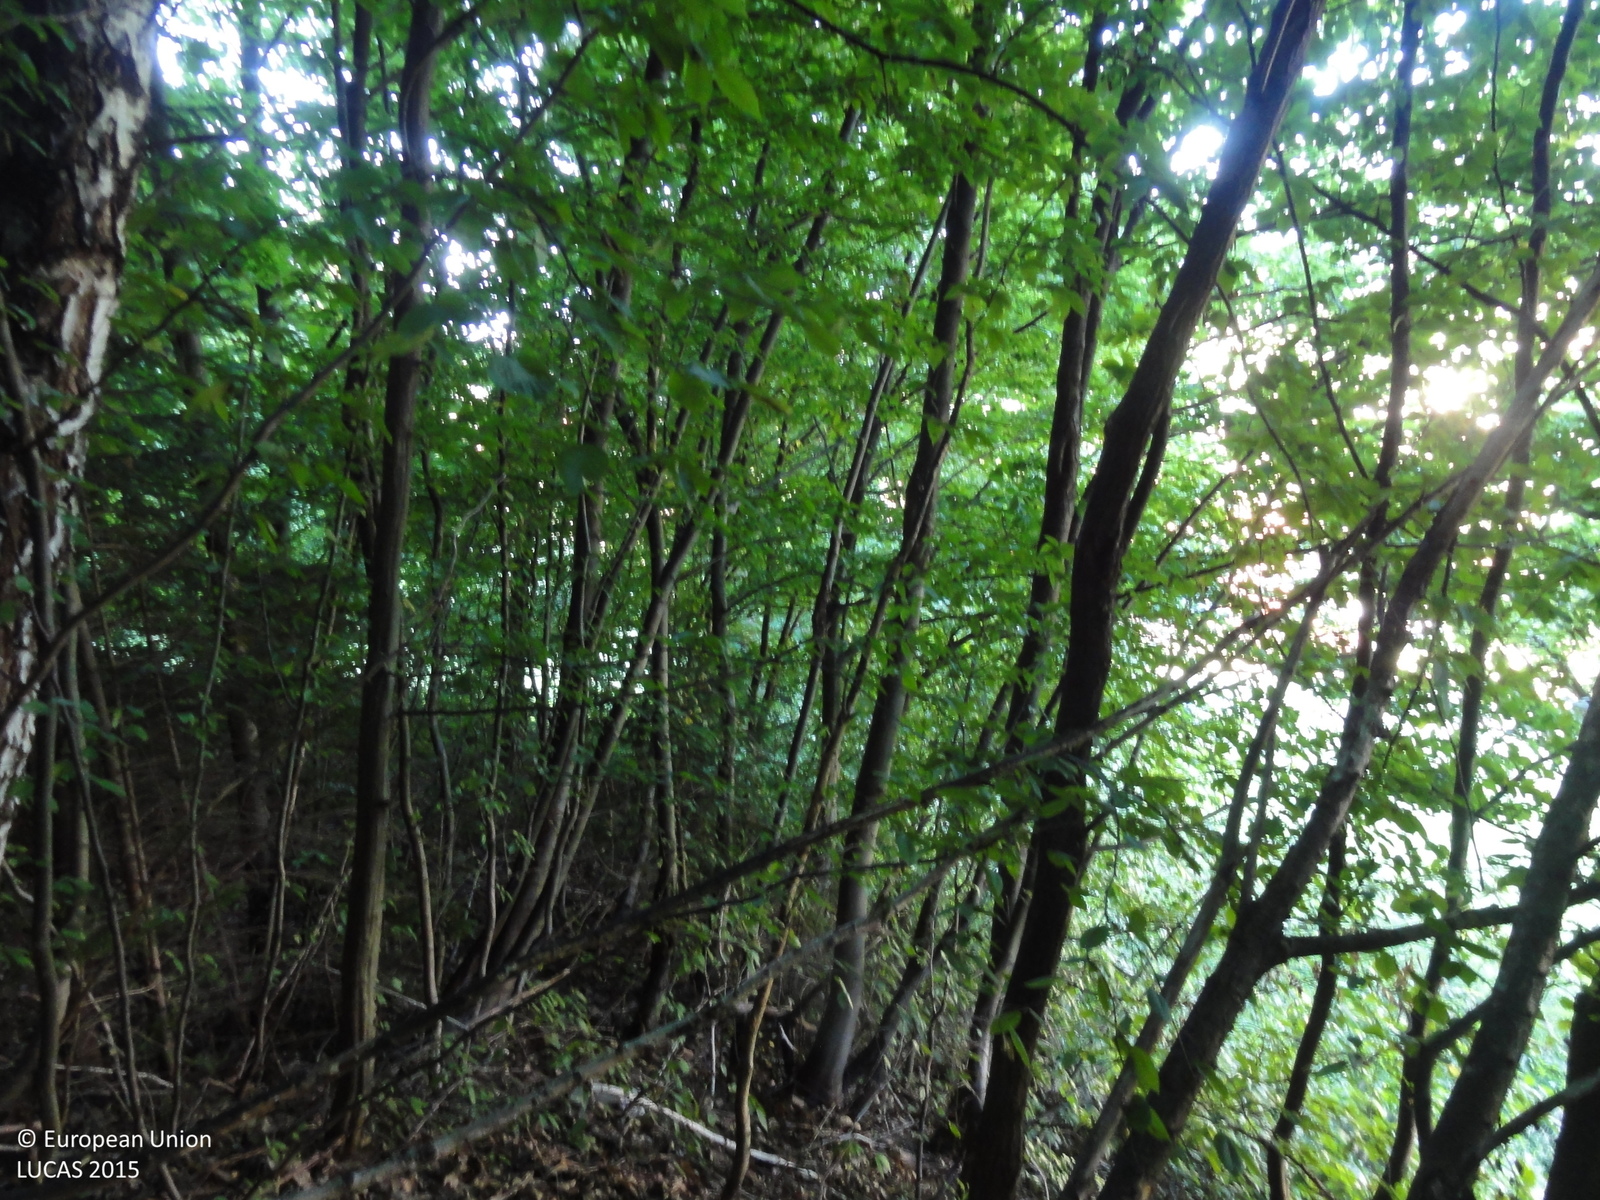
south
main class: Woodland
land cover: Broadleaved woodland
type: mesophytic deciduous forest
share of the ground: > 75 %
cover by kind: broadleaved forest trees 100 %
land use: Forestry
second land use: Amenities, museums, leisure
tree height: > 5 m
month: July
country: SI
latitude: 46.3222
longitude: 15.0499
